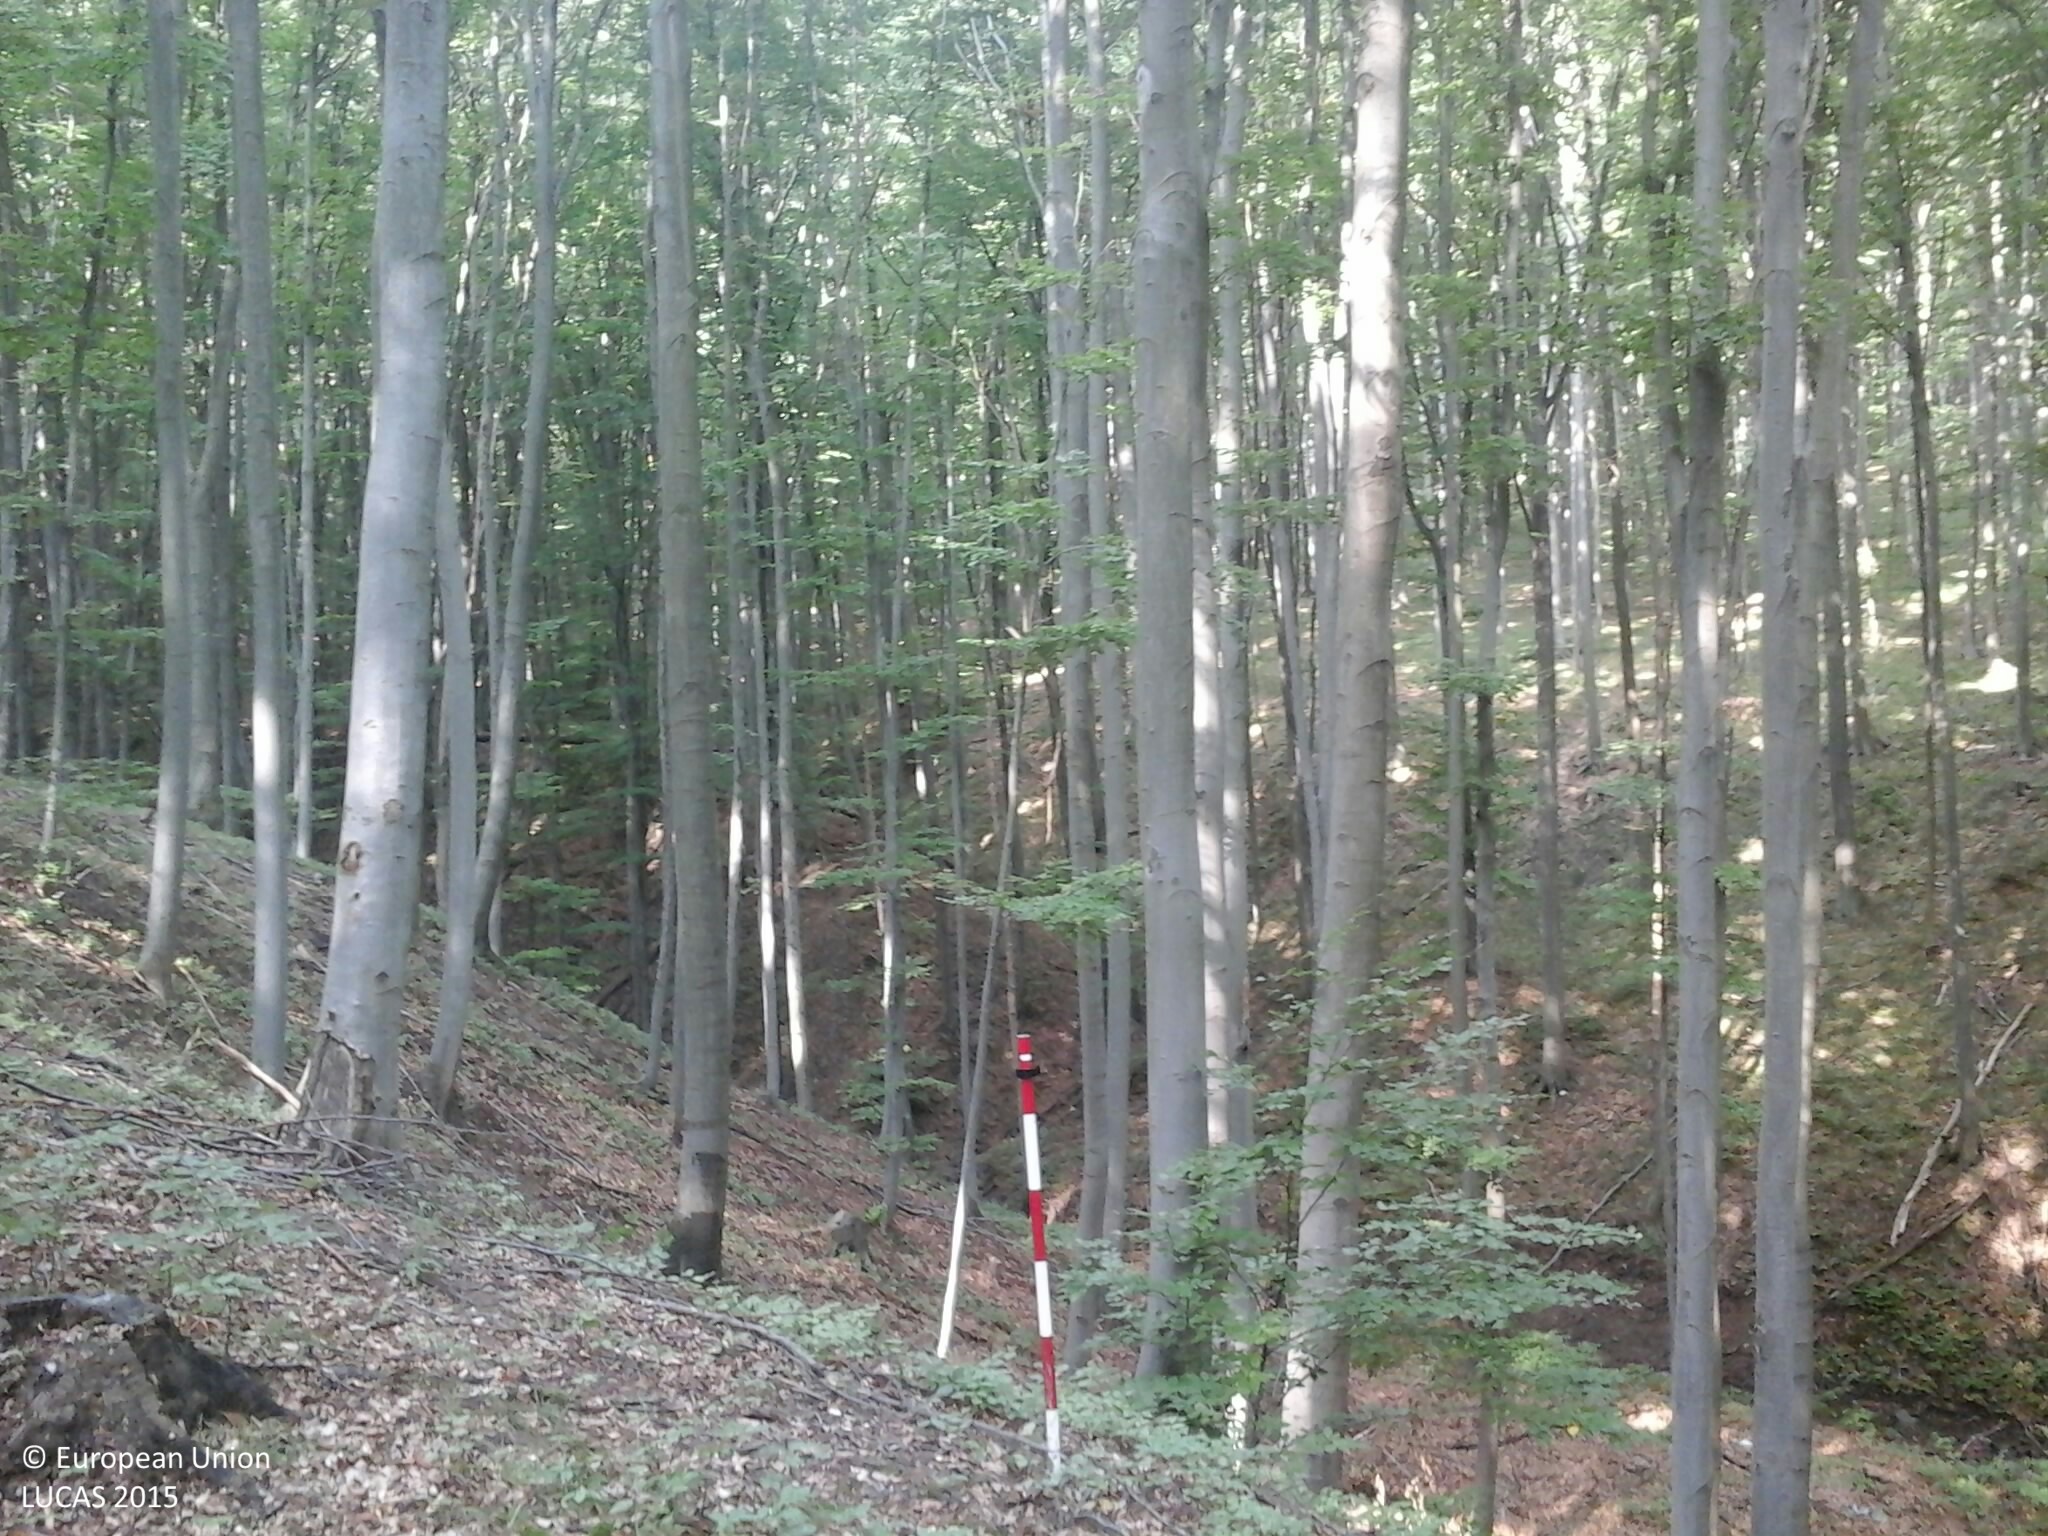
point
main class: Woodland
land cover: Broadleaved woodland
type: beech forest
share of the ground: > 75 %
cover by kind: broadleaved forest trees 95 %, herbaceous plants 5 %
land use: Forestry
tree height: > 5 m
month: September
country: HU
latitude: 47.9156
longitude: 19.9693
